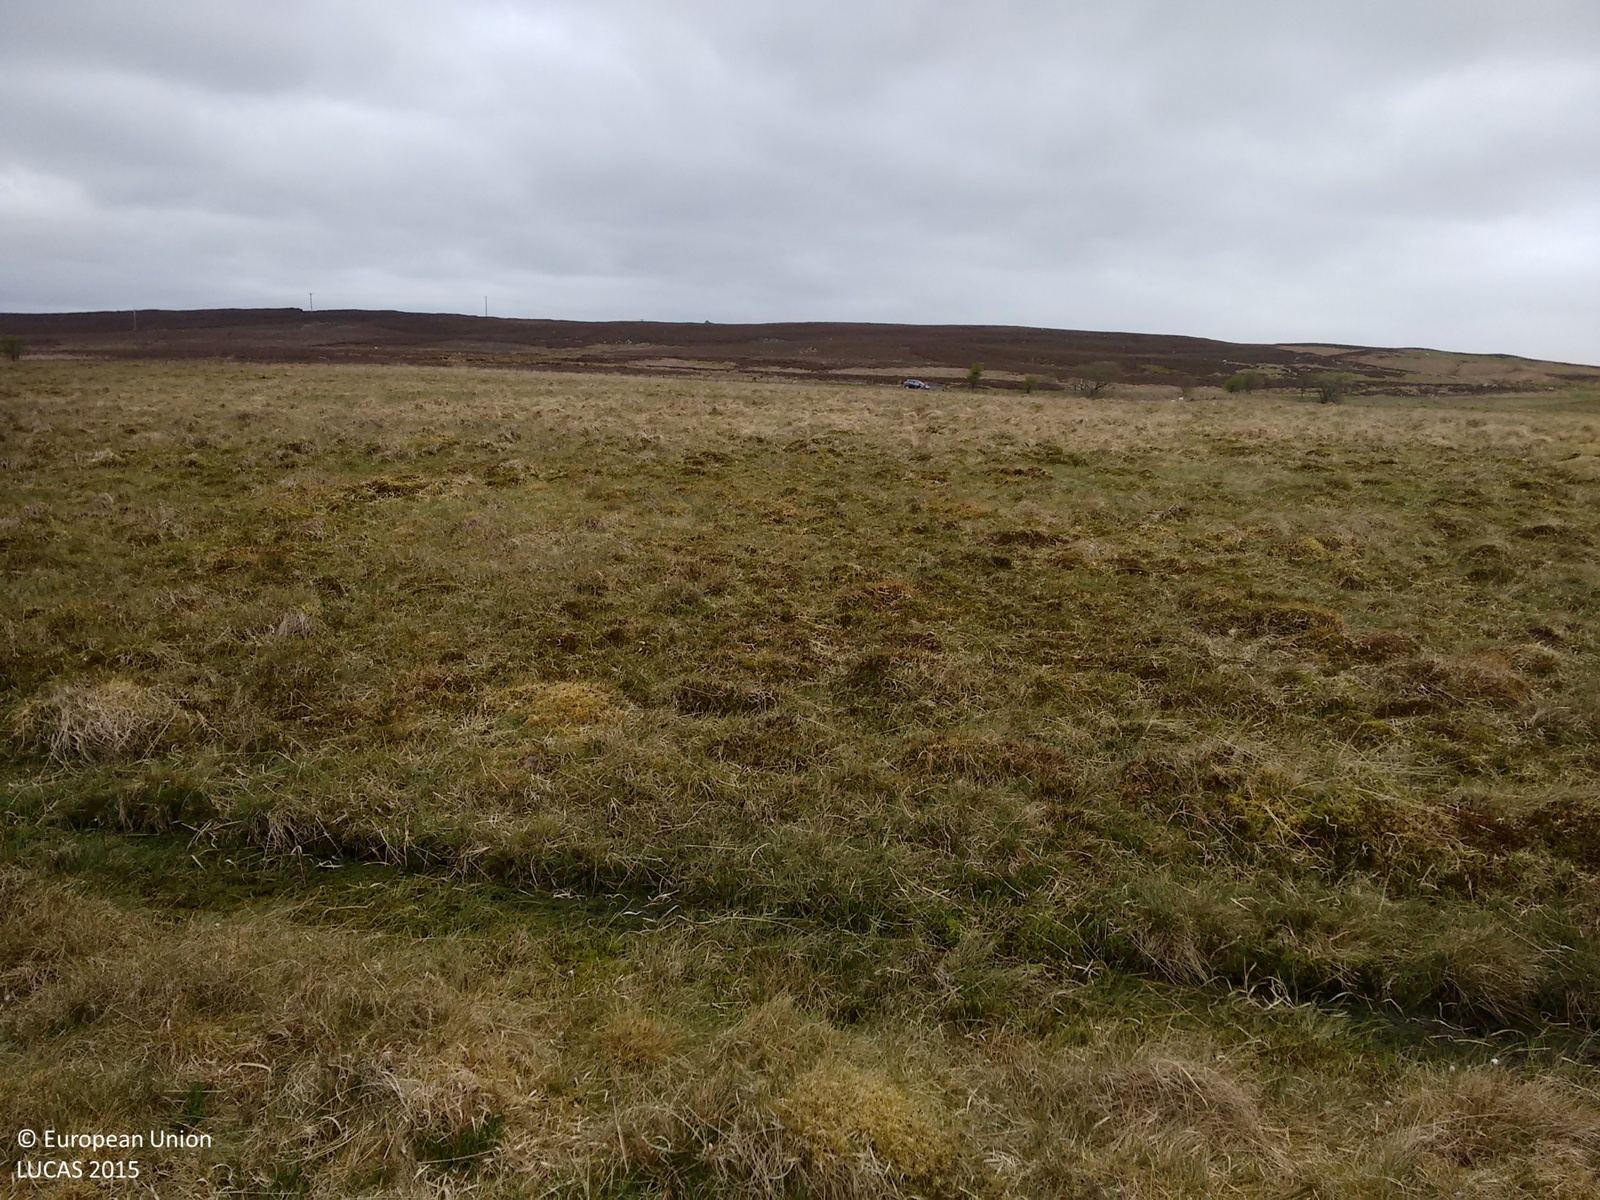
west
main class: Grassland
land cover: Grassland without tree/shrub cover
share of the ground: > 75 %
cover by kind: herbaceous plants 100 %
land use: Agriculture (excluding fallow land and kitchen gardens)
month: May
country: GB
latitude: 55.1819
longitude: -2.0369
